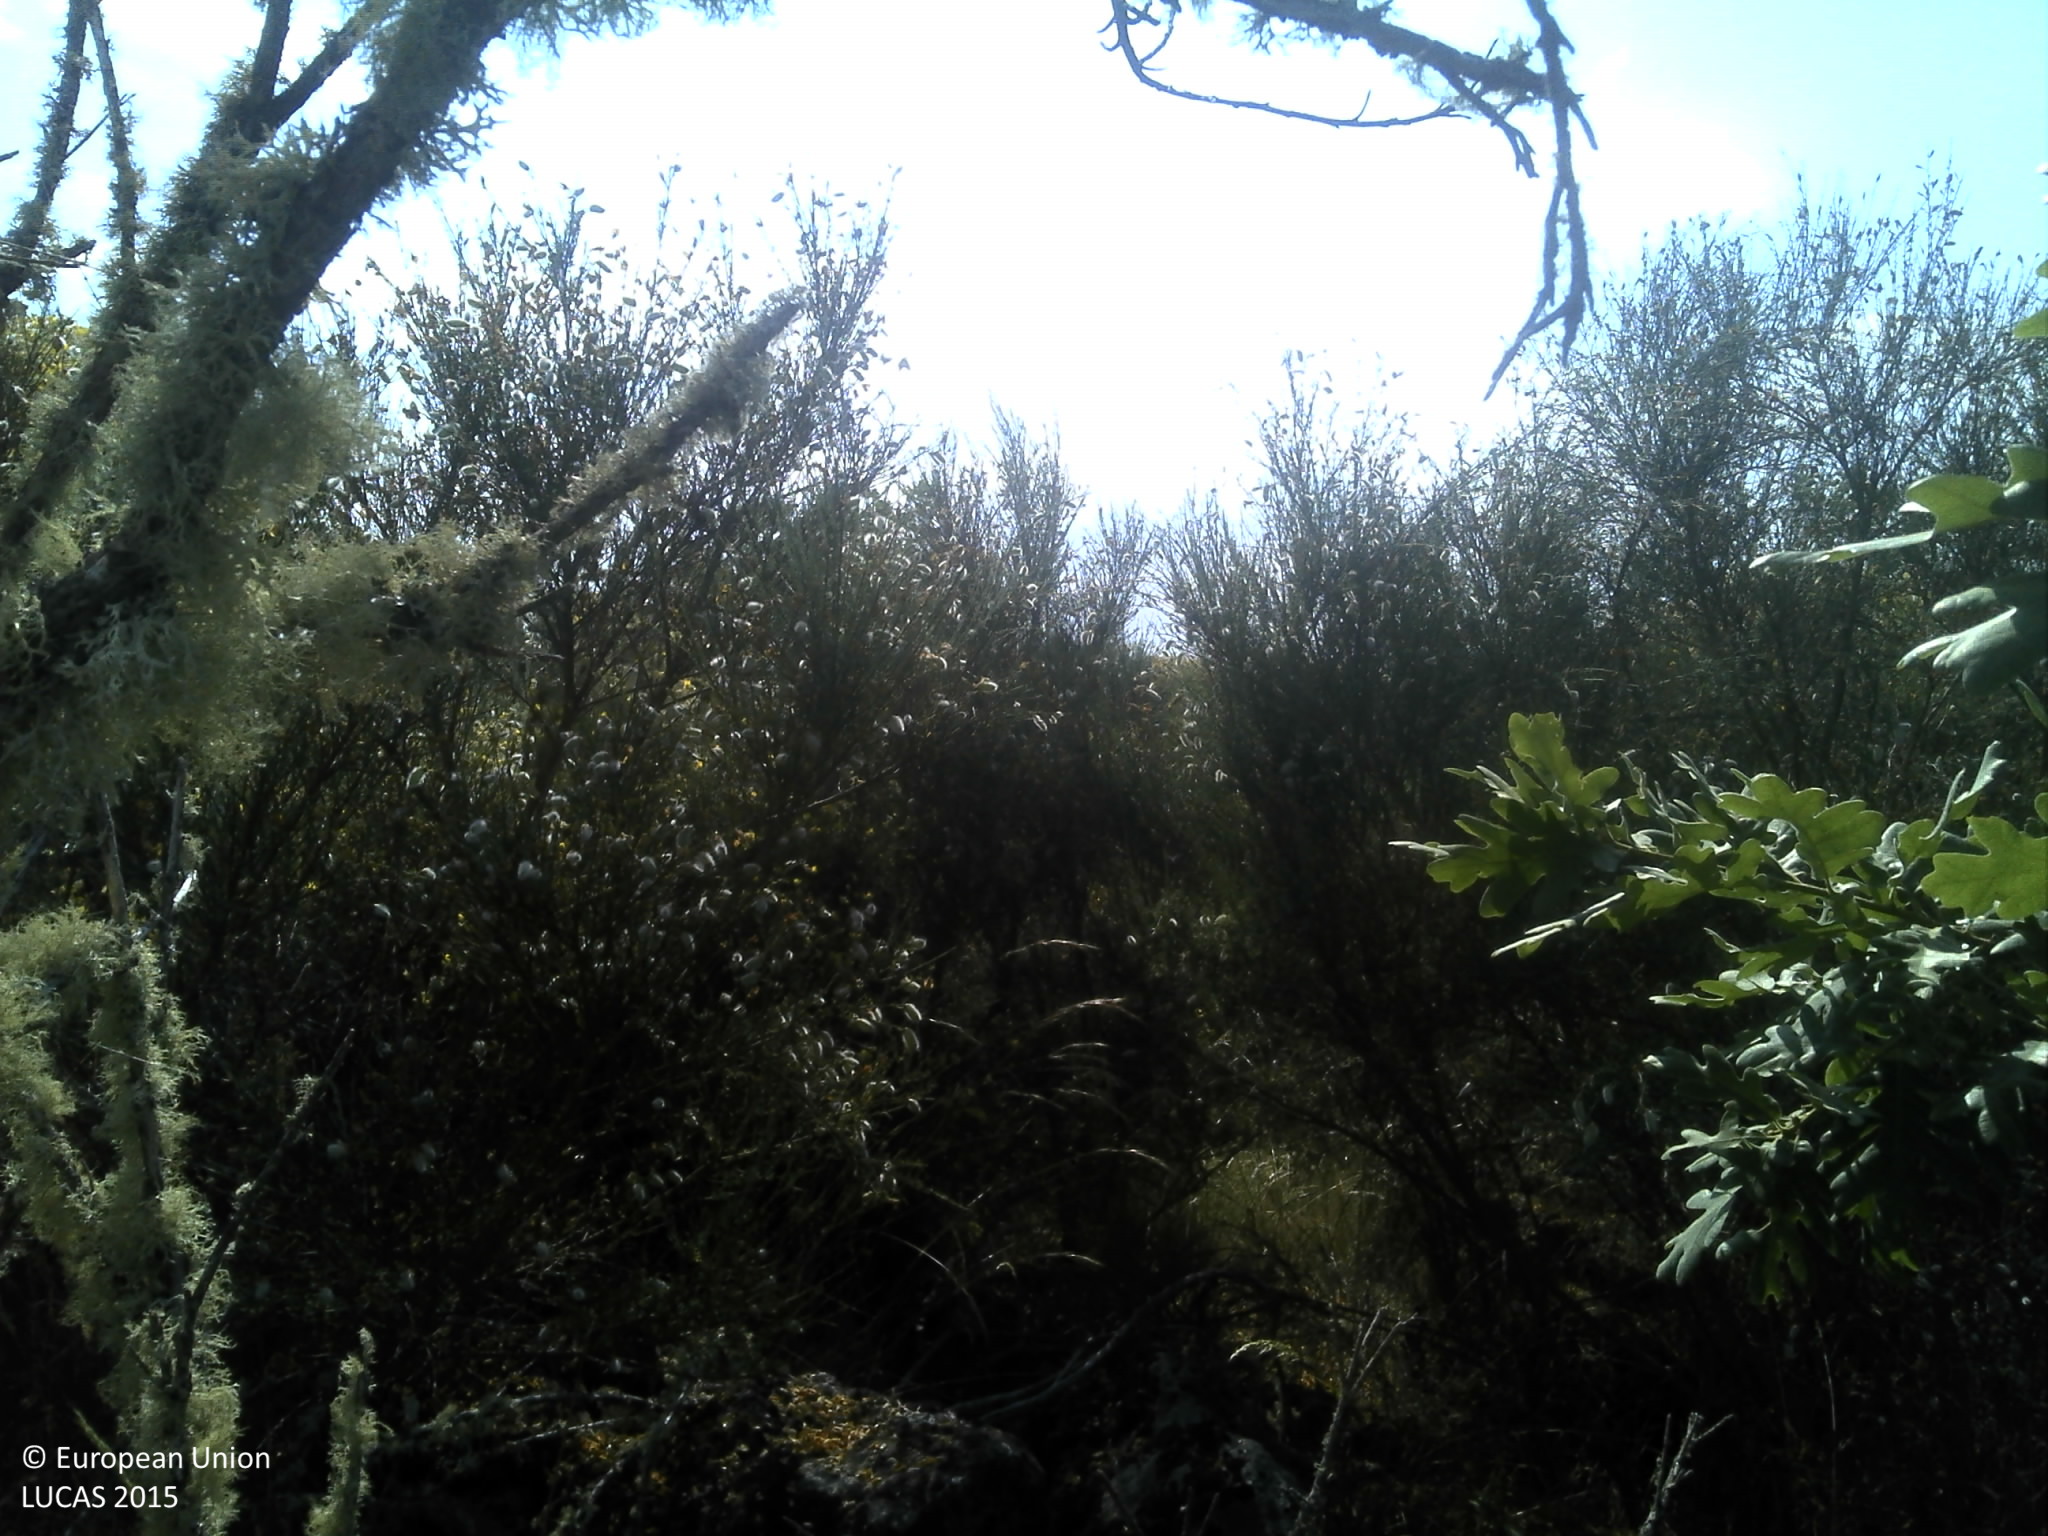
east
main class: Shrubland
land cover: Shrubland with sparse tree cover
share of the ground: 50 - 75 %
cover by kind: shrubs 75 %, unconsolidated bare surface 10 %, broadleaved forest trees 5 %
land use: Abandoned areas
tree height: < 5 m
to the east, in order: Shrubland with sparse tree cover; Dry stone walls; Shrubland with sparse tree cover; Pine dominated coniferous woodland; Grassland without tree/shrub cover; Pine dominated coniferous woodland; Shrubland with sparse tree cover; Dry stone walls; Shrubland with sparse tree cover
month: June
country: PT
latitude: 40.5745
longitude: -7.1253
